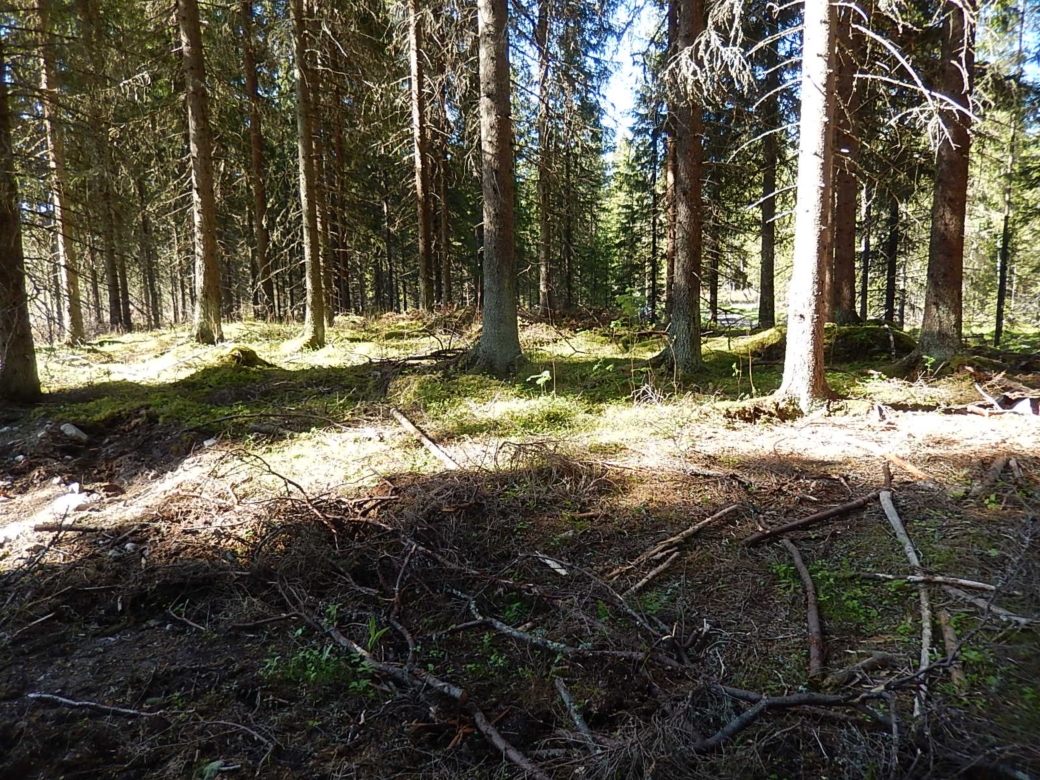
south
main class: Woodland
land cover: Spruce dominated coniferous woodland
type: boreal forest
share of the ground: > 75 %
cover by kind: coniferous forest trees 80 %, shrubs 10 %, lichens and mosses 5 %, unconsolidated bare surface 5 %
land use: Forestry
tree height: > 5 m
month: June
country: FI
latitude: 62.0455
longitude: 21.6944
